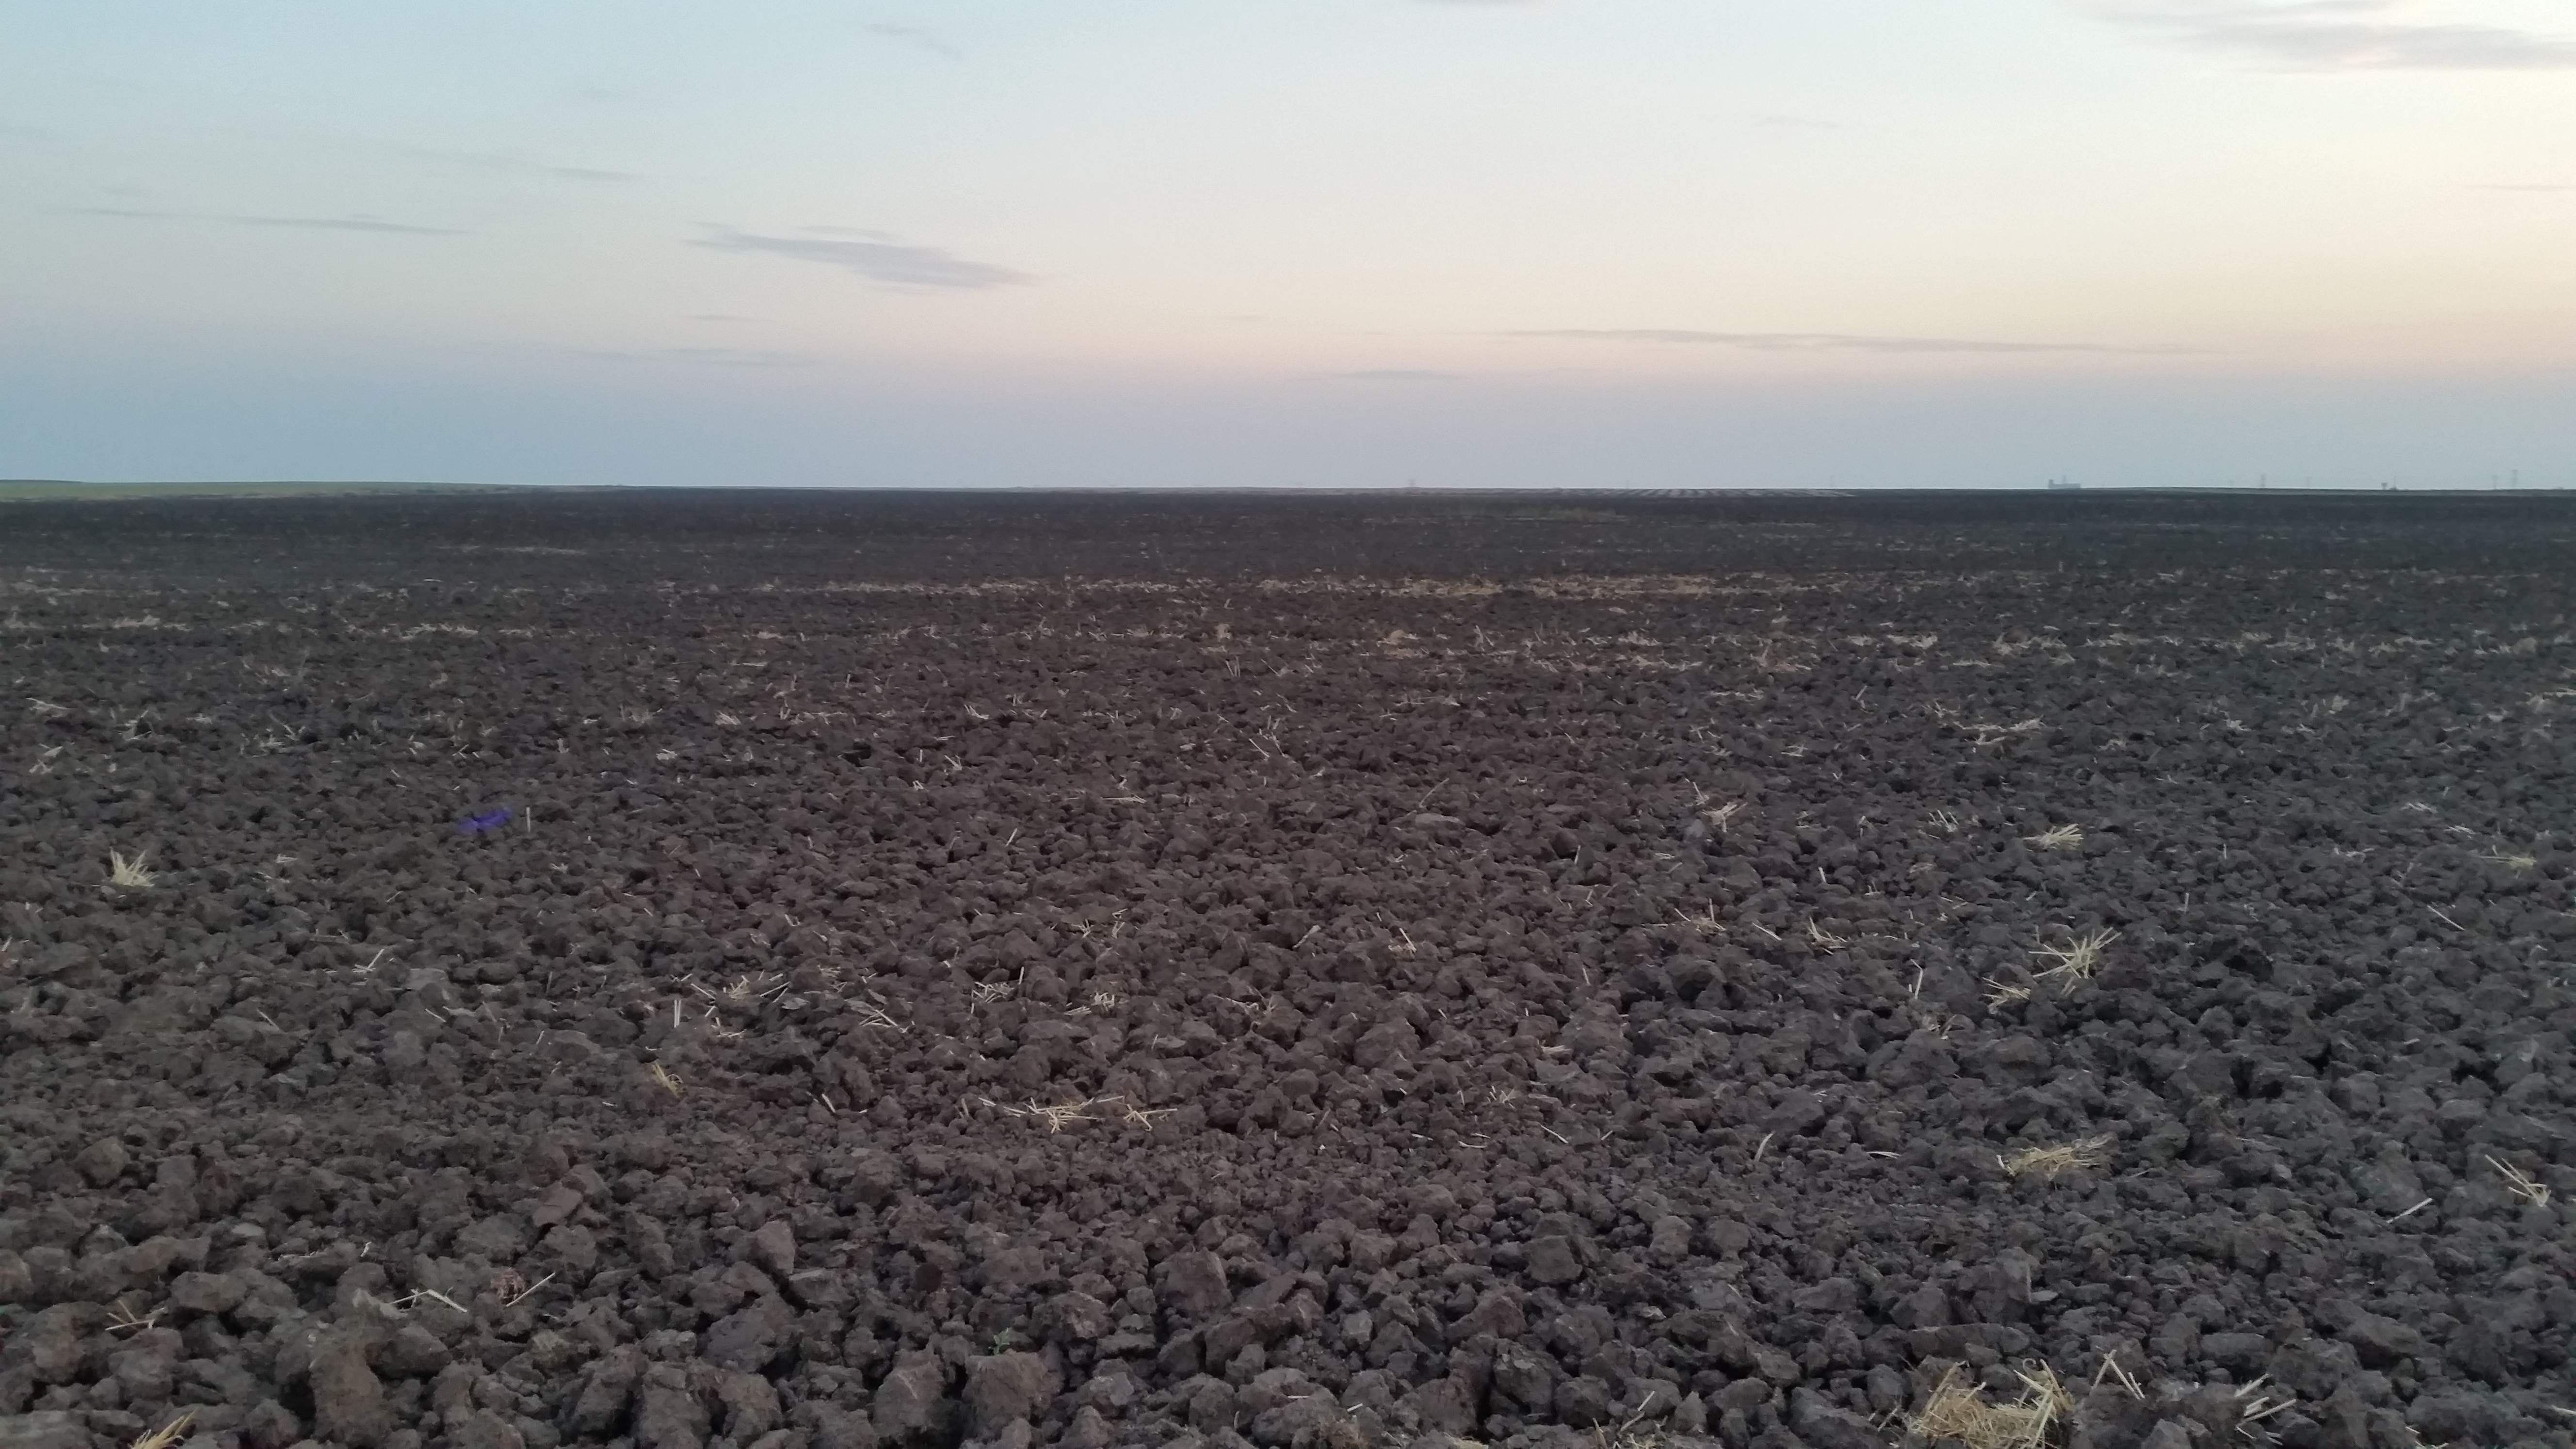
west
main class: Cropland
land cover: Common wheat
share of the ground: < 10 %
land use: Agriculture (excluding fallow land and kitchen gardens)
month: August
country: RO
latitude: 44.0587
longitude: 23.6969
